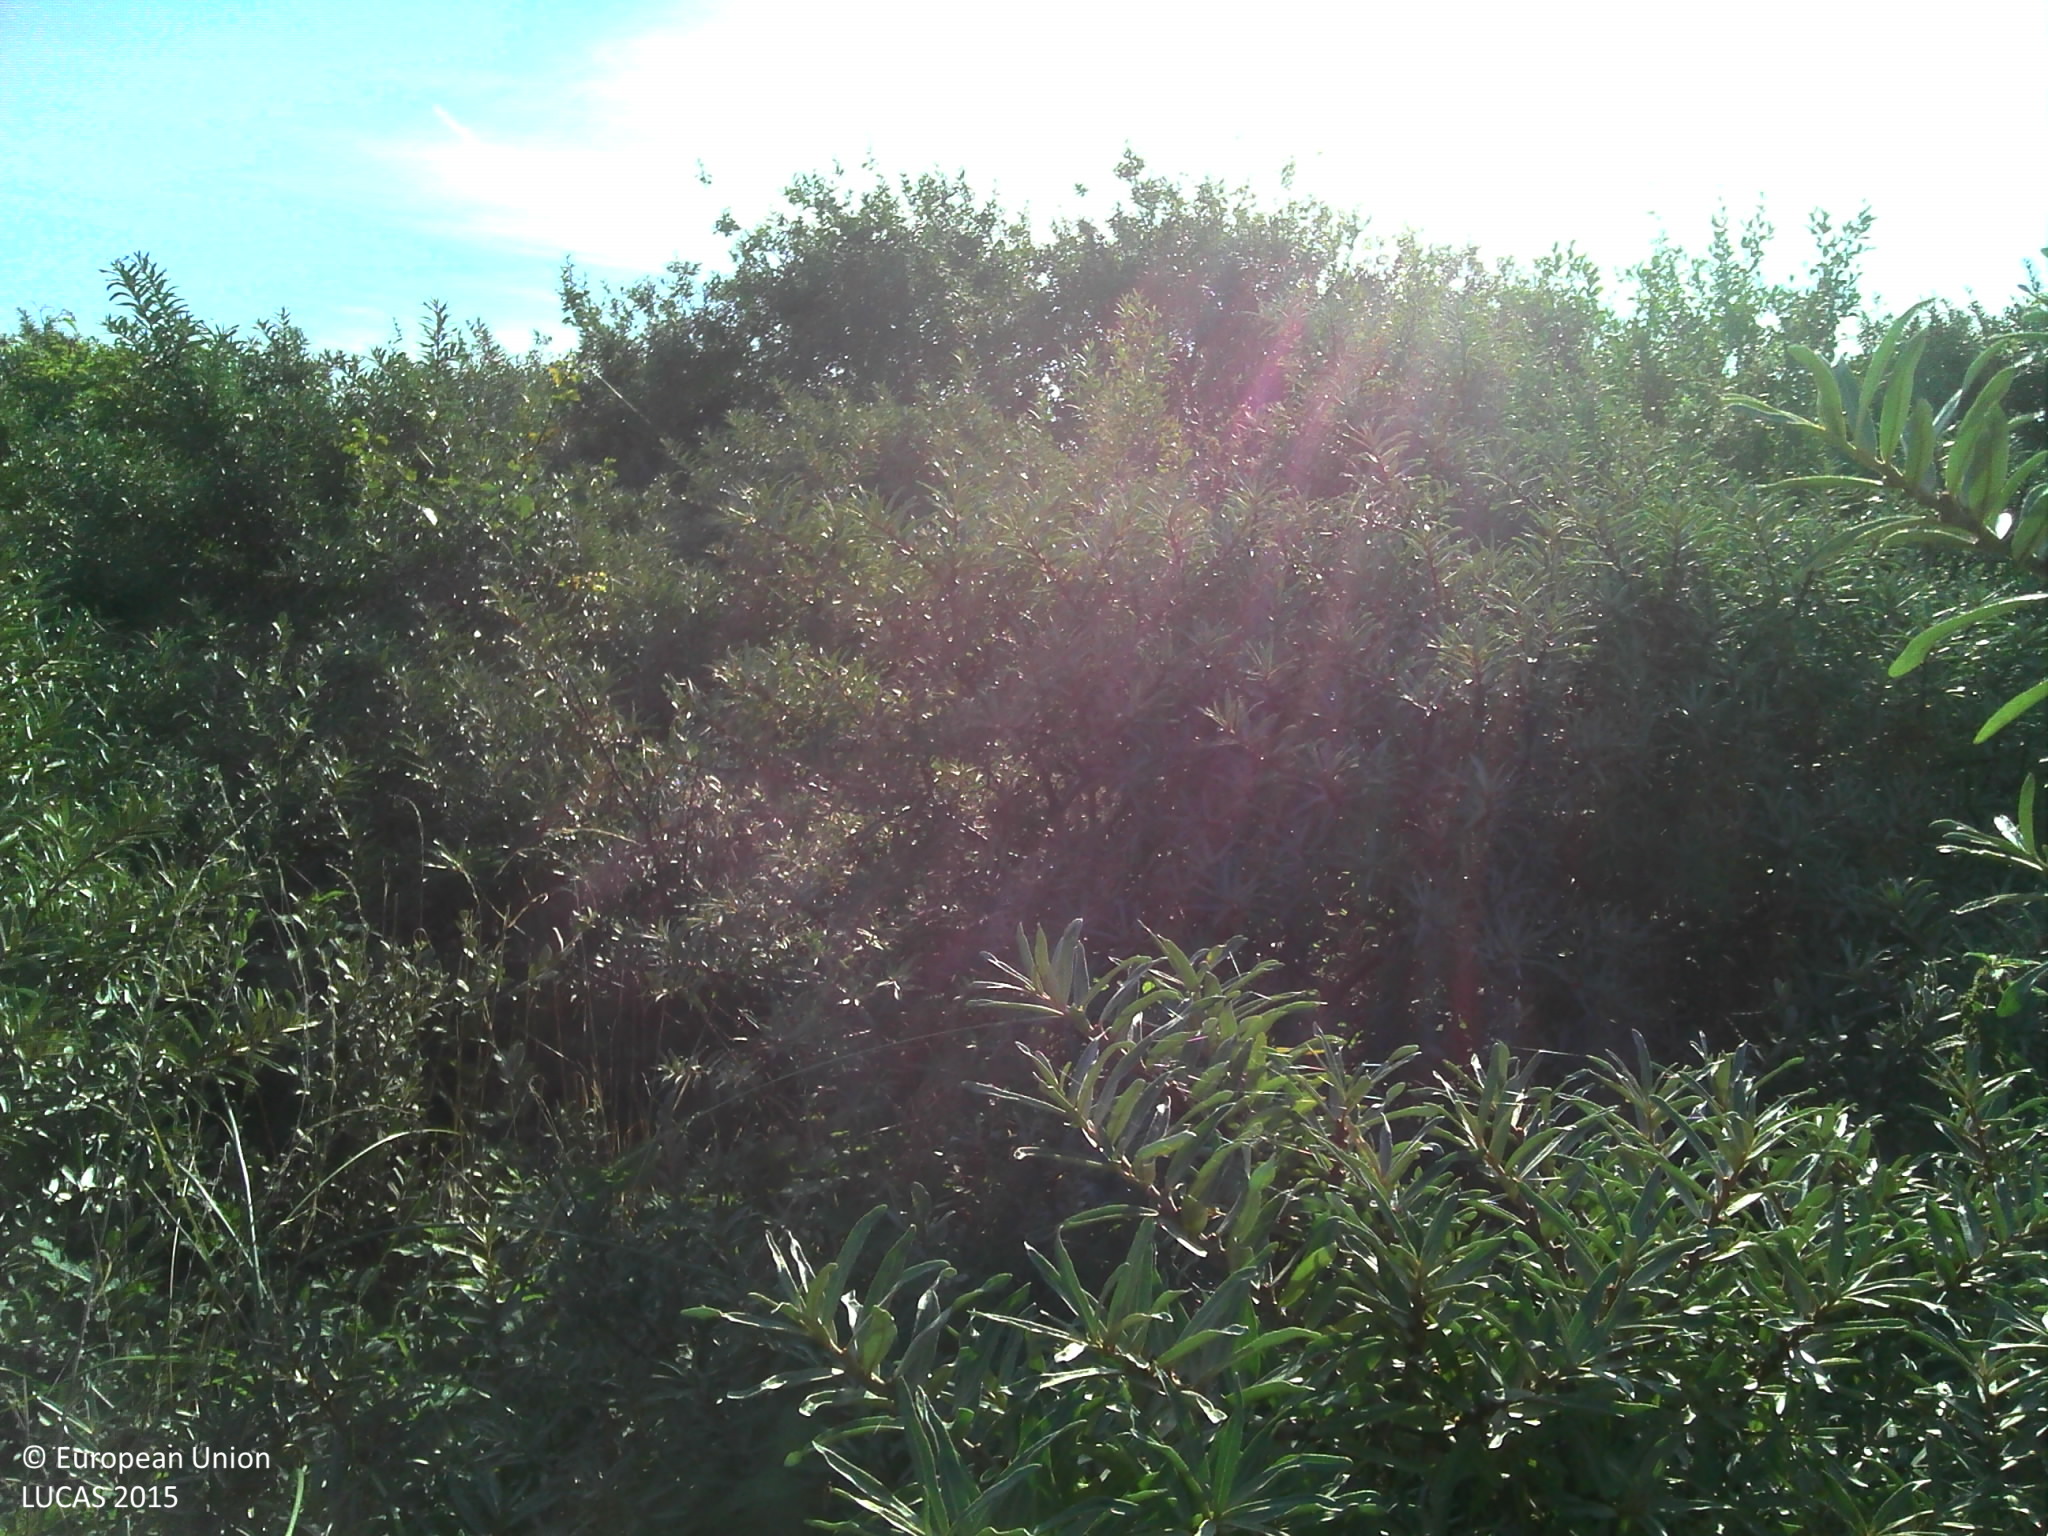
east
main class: Shrubland
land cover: Shrubland without tree cover
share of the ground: > 75 %
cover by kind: shrubs 80 %, herbaceous plants 20 %
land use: Semi-natural and natural areas not in use
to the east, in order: Shrubland without tree cover; Artificial constructions in urban areas; Ditches and canals; Fences; Grassland without tree/shrub cover
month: September
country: BE
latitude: 51.1640
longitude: 2.7670
